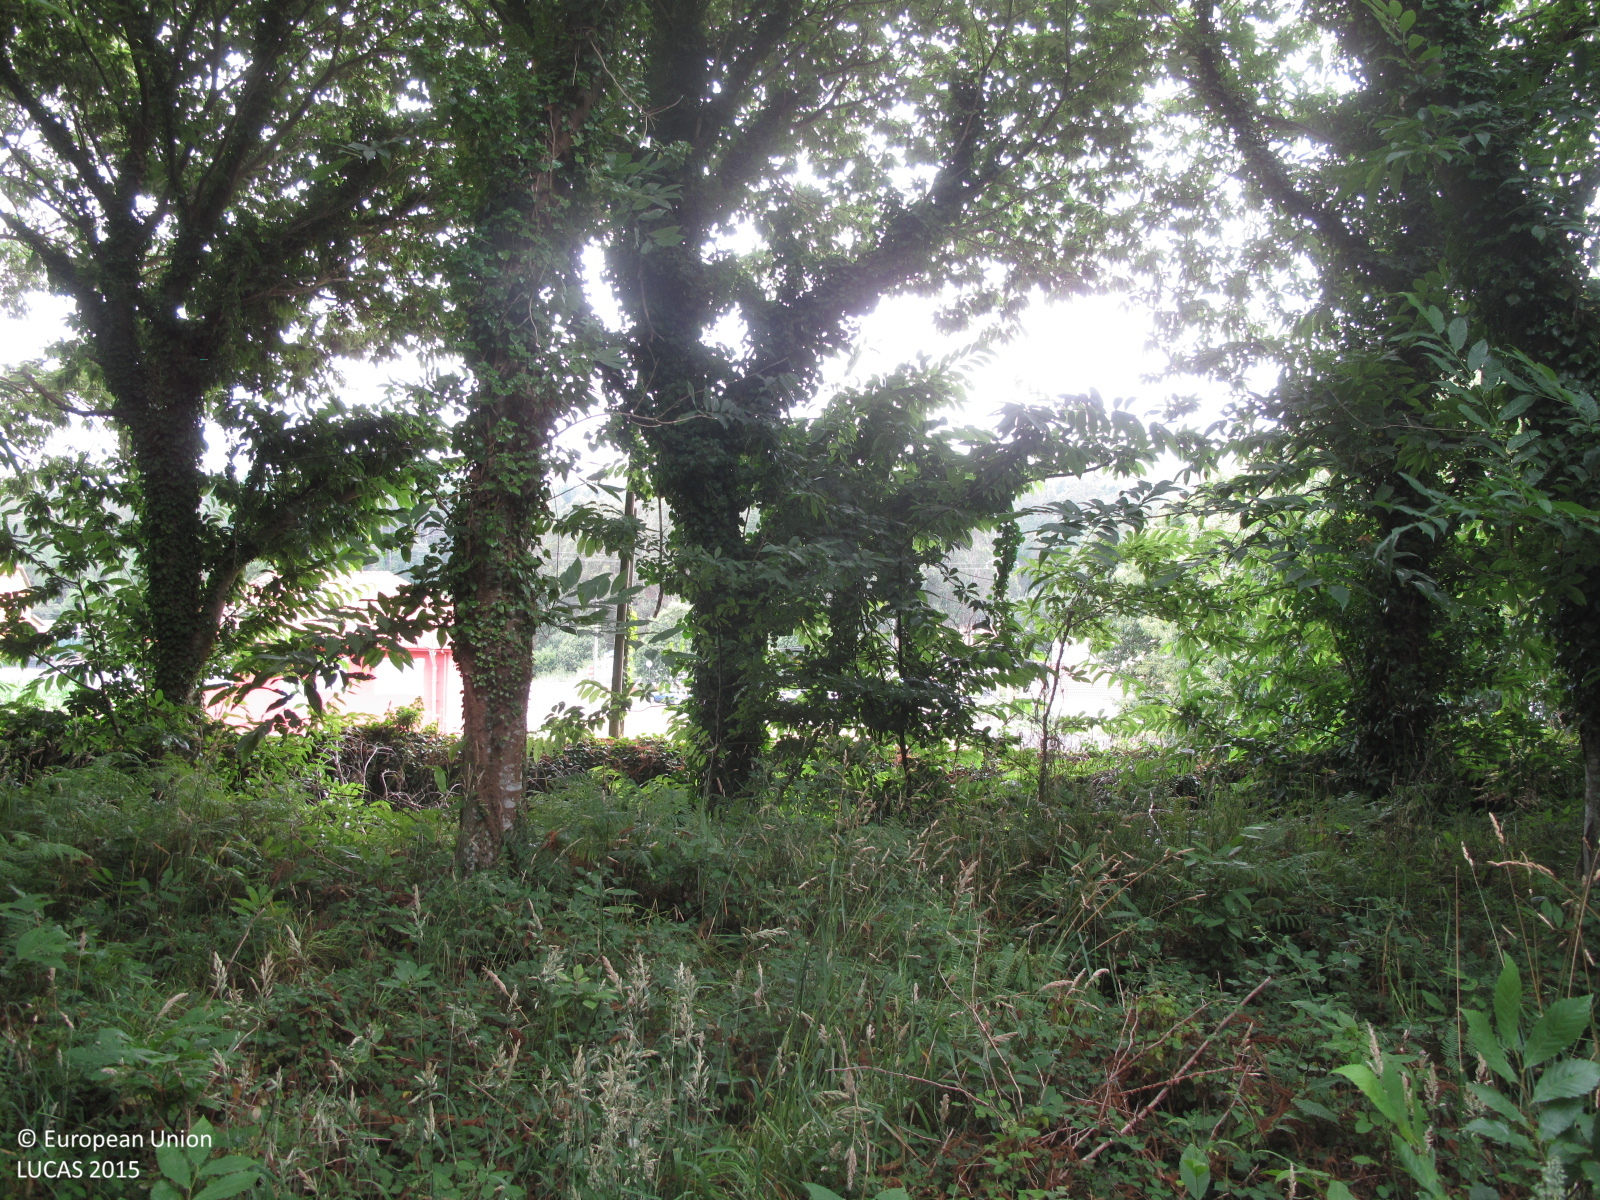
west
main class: Woodland
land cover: Broadleaved woodland
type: thermophilous deciduous forest
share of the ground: > 75 %
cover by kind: broadleaved forest trees 90 %, shrubs 5 %, herbaceous plants 5 %
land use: Forestry
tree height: > 5 m
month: July
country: ES
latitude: 43.1387
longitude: -9.1475
